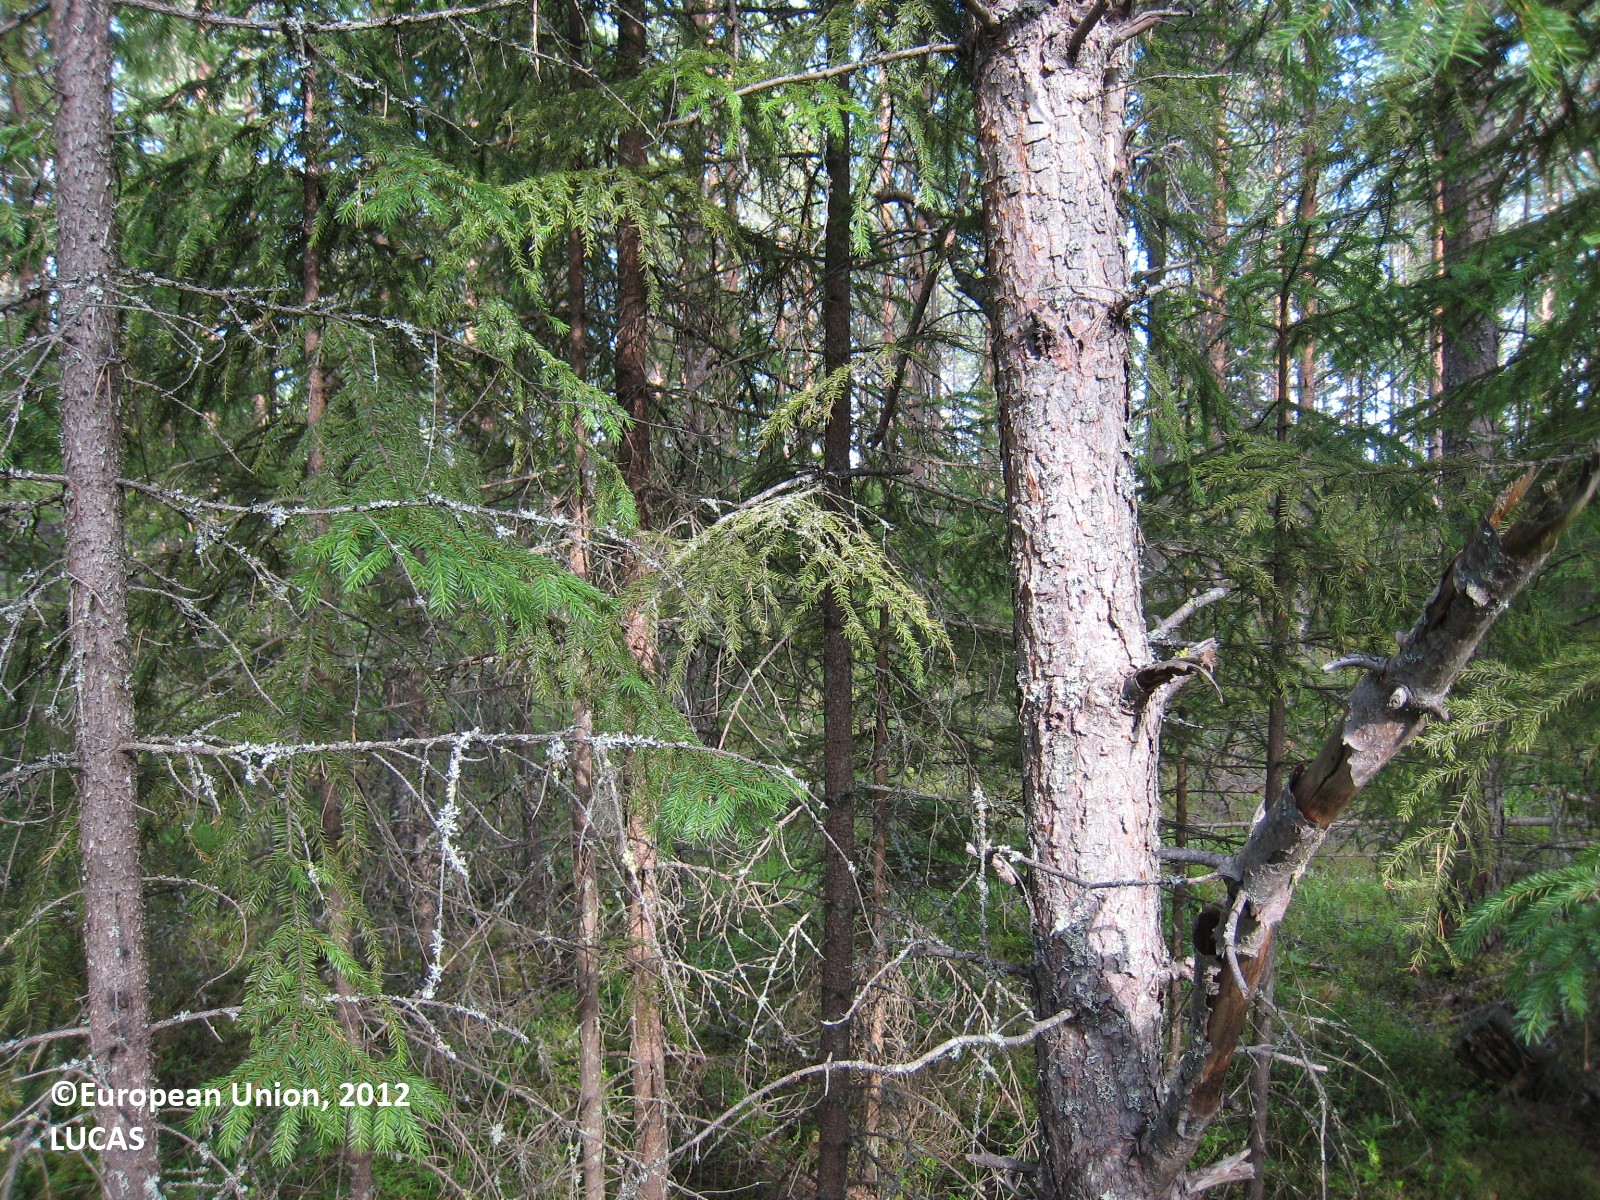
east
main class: Woodland
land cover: Other coniferous woodland
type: boreal forest
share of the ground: 50 - 75 %
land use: Forestry
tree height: > 5 m
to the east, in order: Other coniferous woodland; Pine dominated coniferous woodland; Other coniferous woodland
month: July
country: FI
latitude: 62.7786
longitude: 25.6920
